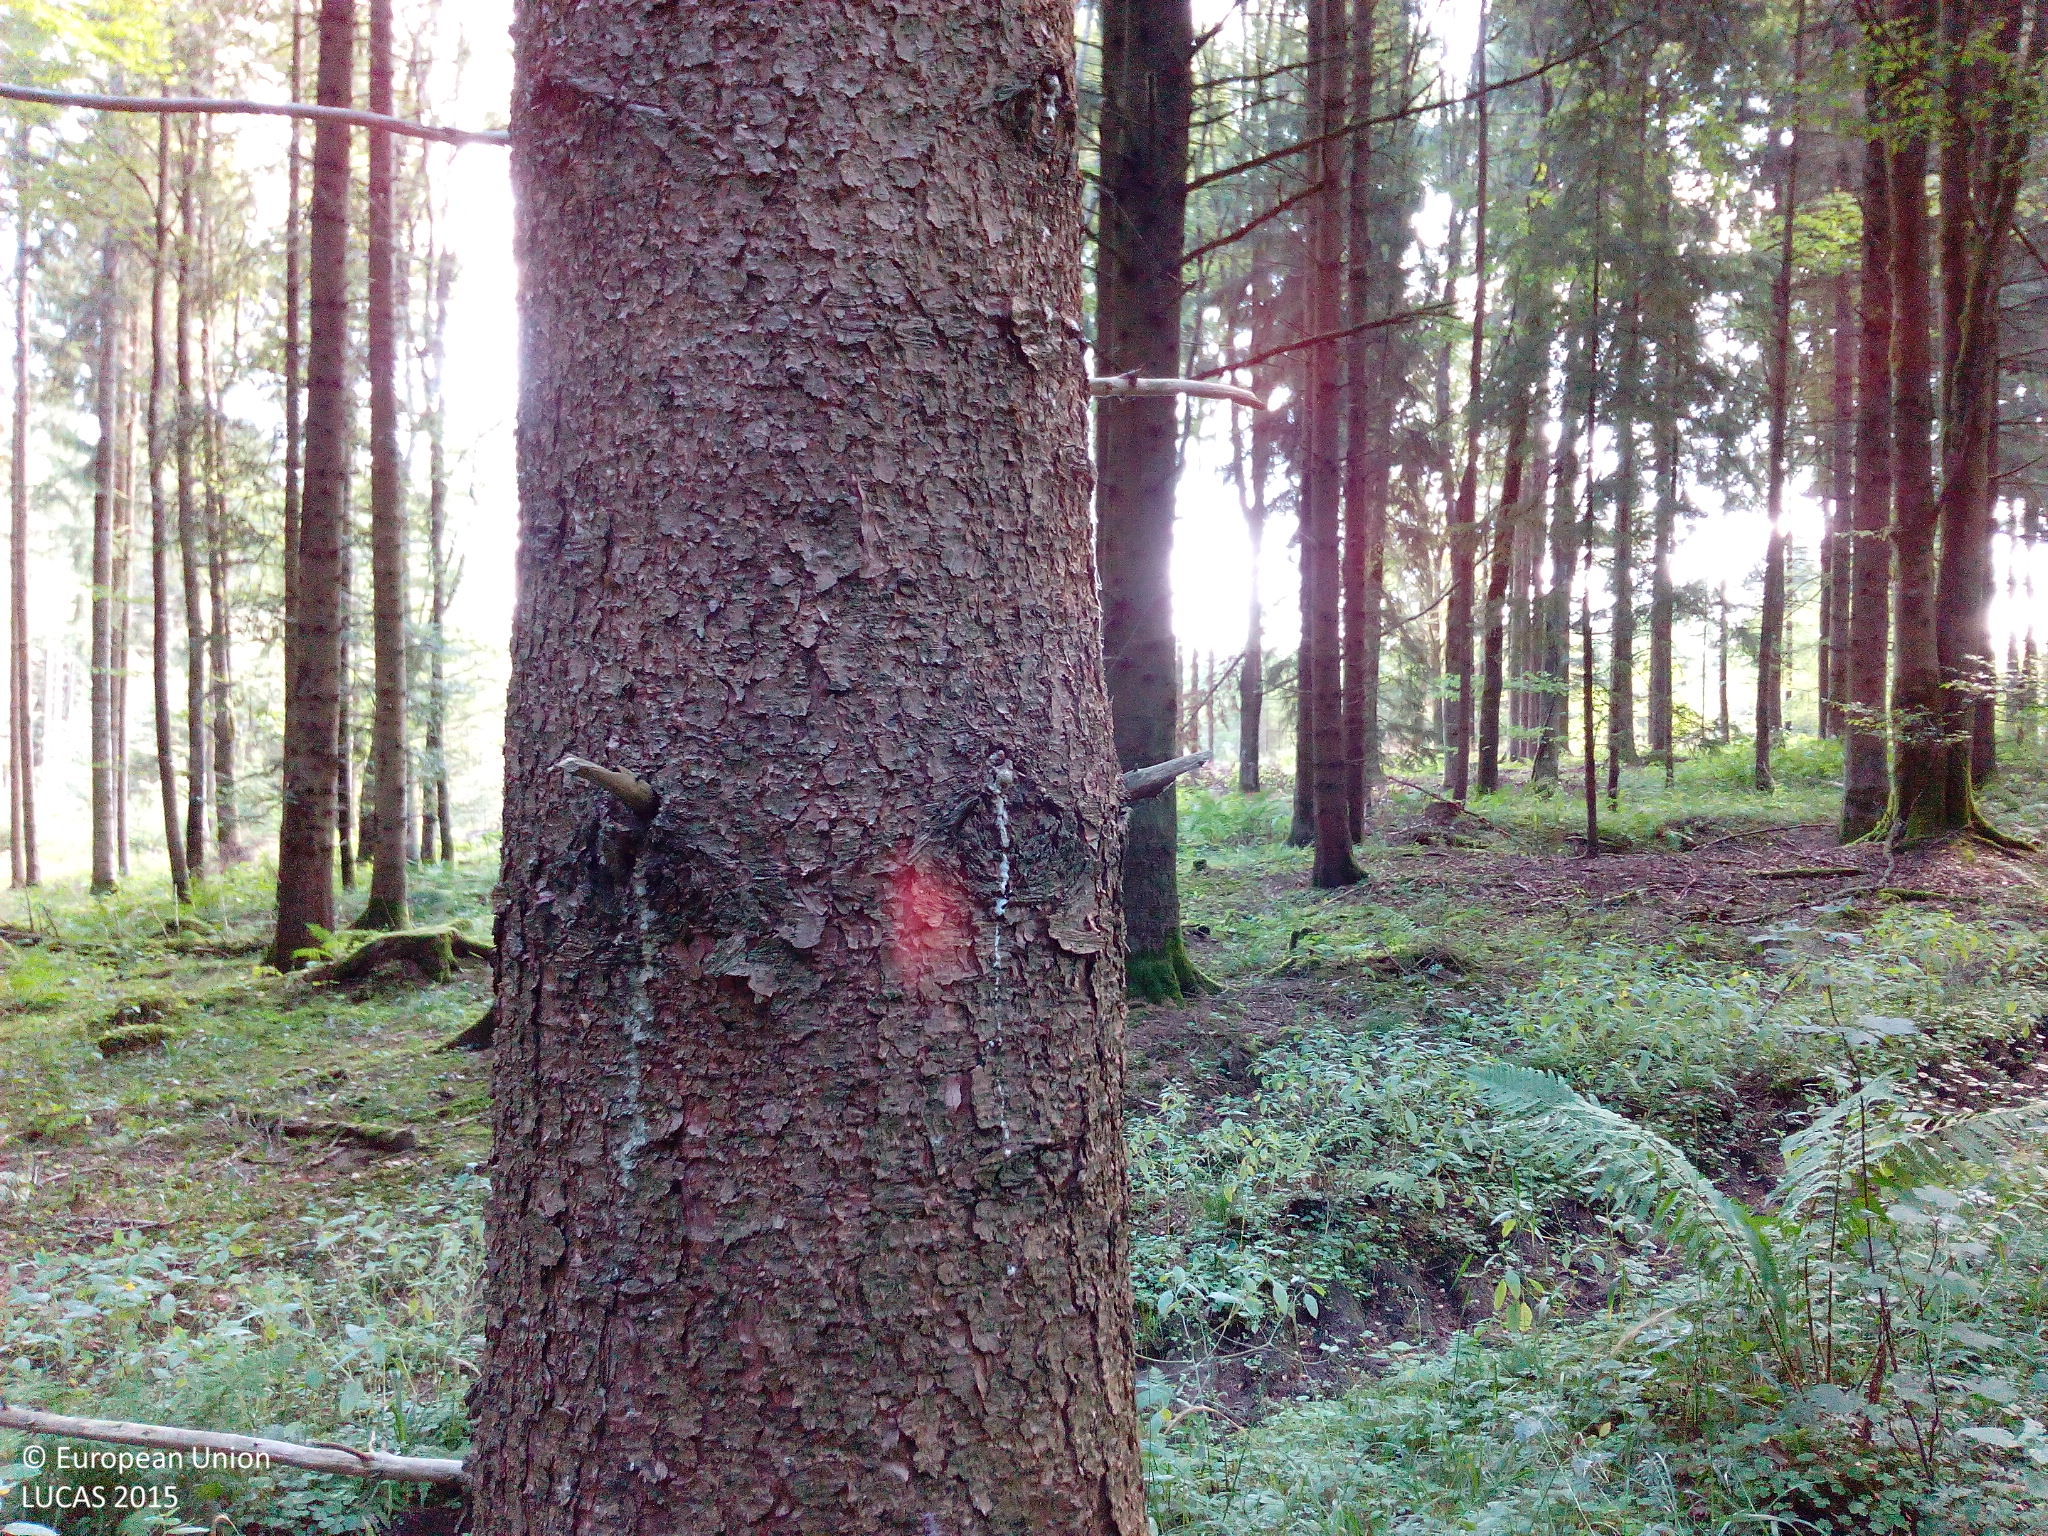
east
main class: Woodland
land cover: Spruce dominated coniferous woodland
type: hemiboreal forest and nemoral coniferous forest and mixed broadleaved-coniferous forest
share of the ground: 50 - 75 %
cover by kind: coniferous forest trees 55 %, herbaceous plants 20 %, lichens and mosses 10 %, broadleaved forest trees 5 %, shrubs 5 %, unconsolidated bare surface 5 %
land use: Forestry
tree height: > 5 m
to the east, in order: Spruce dominated coniferous woodland; Spruce dominated mixed woodland; Tracks; Spruce dominated mixed woodland; Spruce dominated coniferous woodland; Spruce dominated mixed woodland; Broadleaved woodland
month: September
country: DE
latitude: 48.1785
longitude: 8.5887
